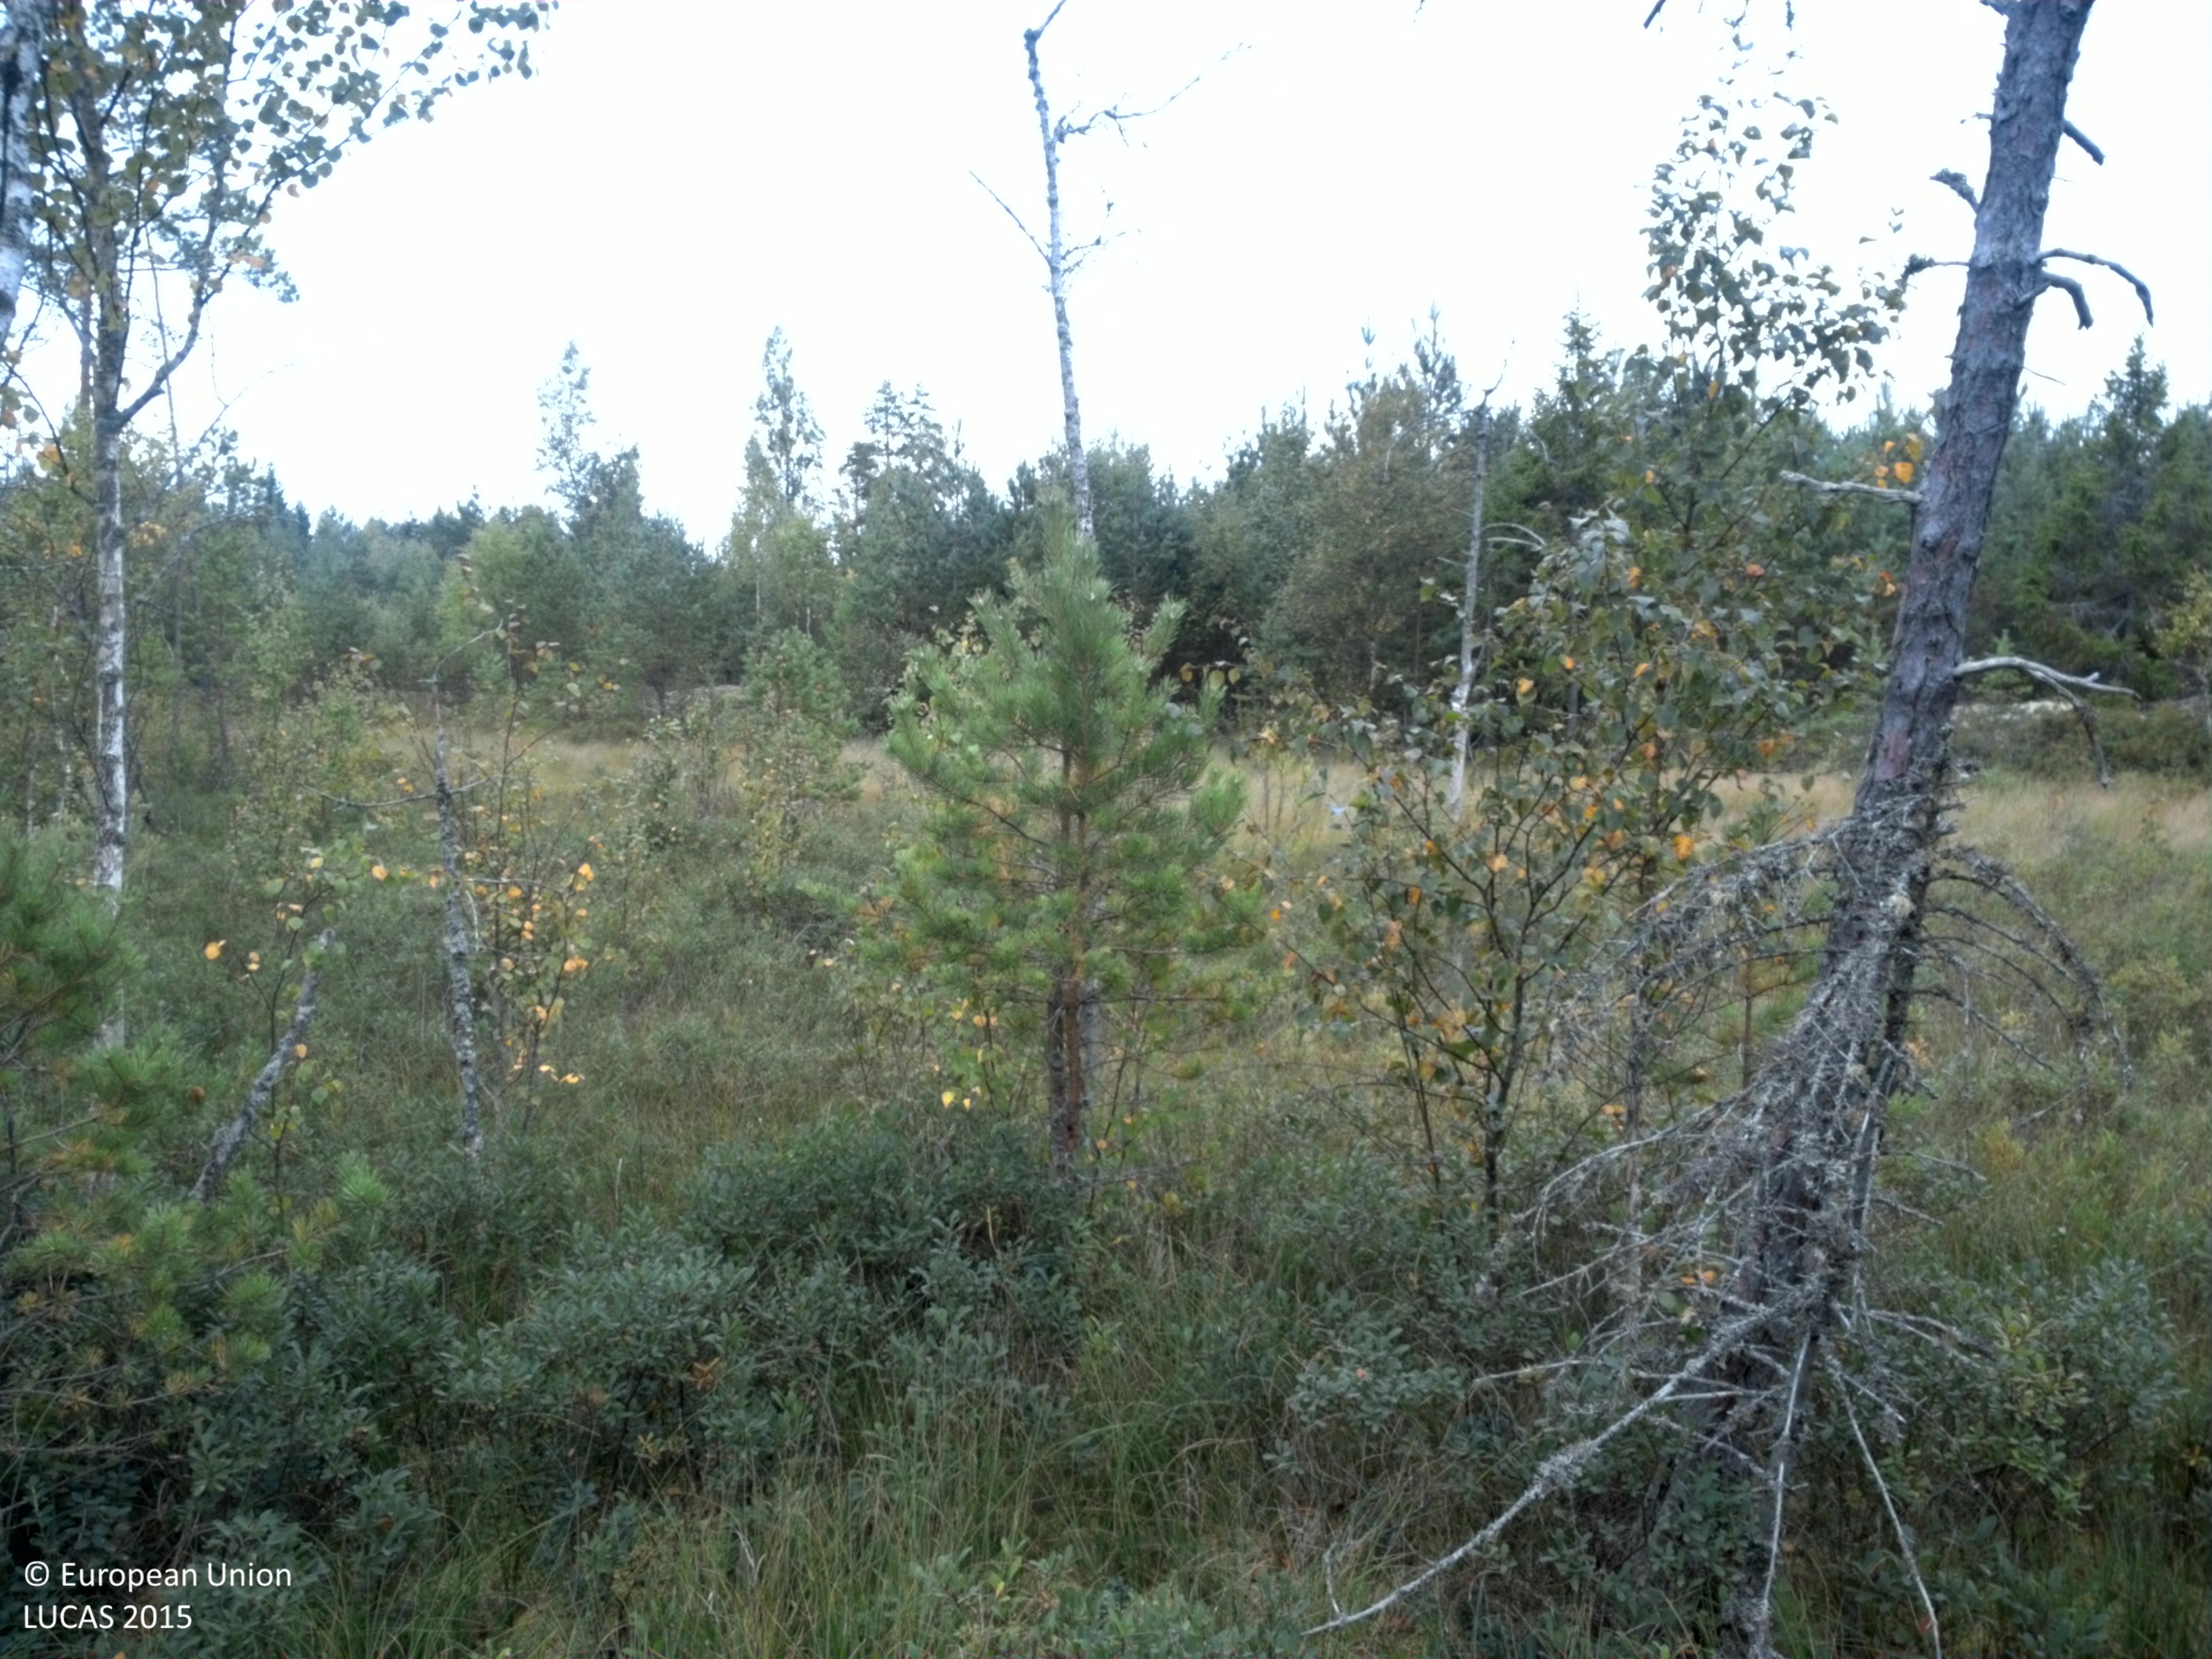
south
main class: Woodland
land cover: Pine dominated mixed woodland
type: boreal forest
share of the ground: 50 - 75 %
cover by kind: lichens and mosses 50 %, coniferous forest trees 35 %, broadleaved forest trees 15 %
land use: Forestry
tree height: < 5 m
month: August
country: SE
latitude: 59.5629
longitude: 17.1969
